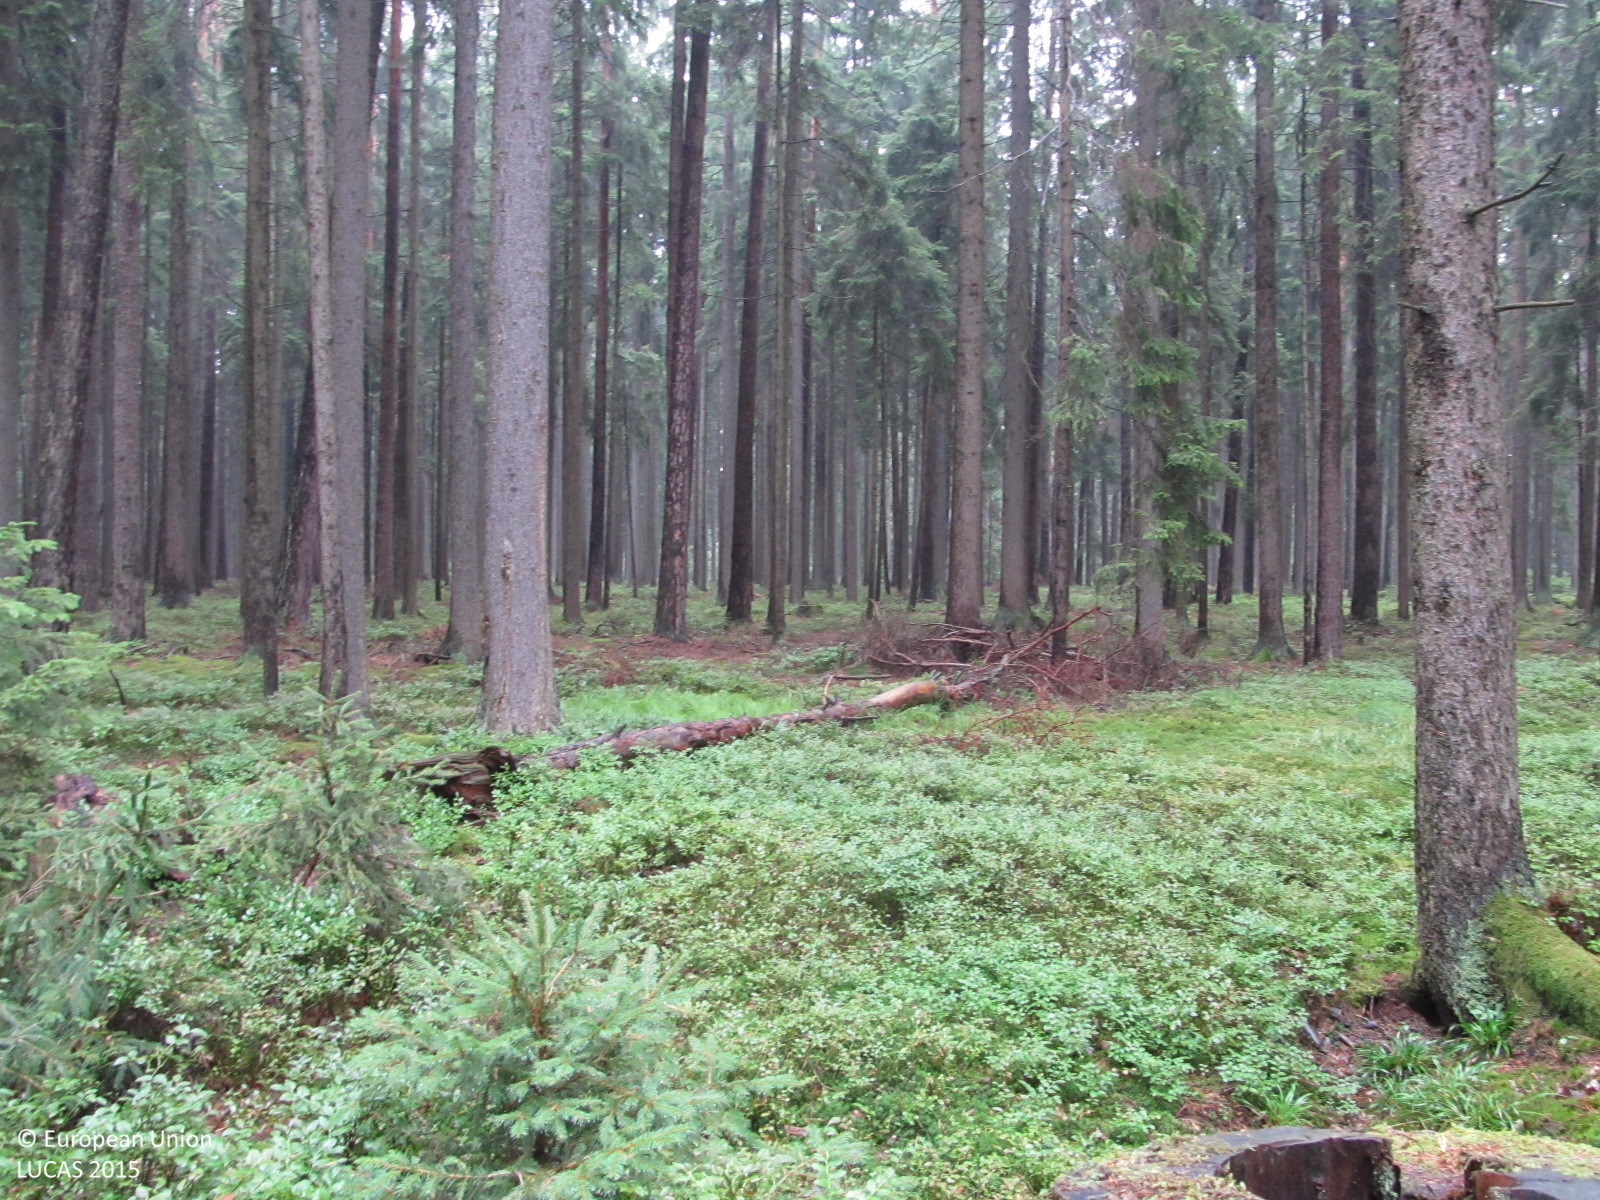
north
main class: Woodland
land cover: Spruce dominated coniferous woodland
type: hemiboreal forest and nemoral coniferous forest and mixed broadleaved-coniferous forest
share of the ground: > 75 %
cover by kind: coniferous forest trees 70 %, herbaceous plants 20 %, shrubs 10 %
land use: Forestry
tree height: > 5 m
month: August
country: AT
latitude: 48.7032
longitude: 15.4245
